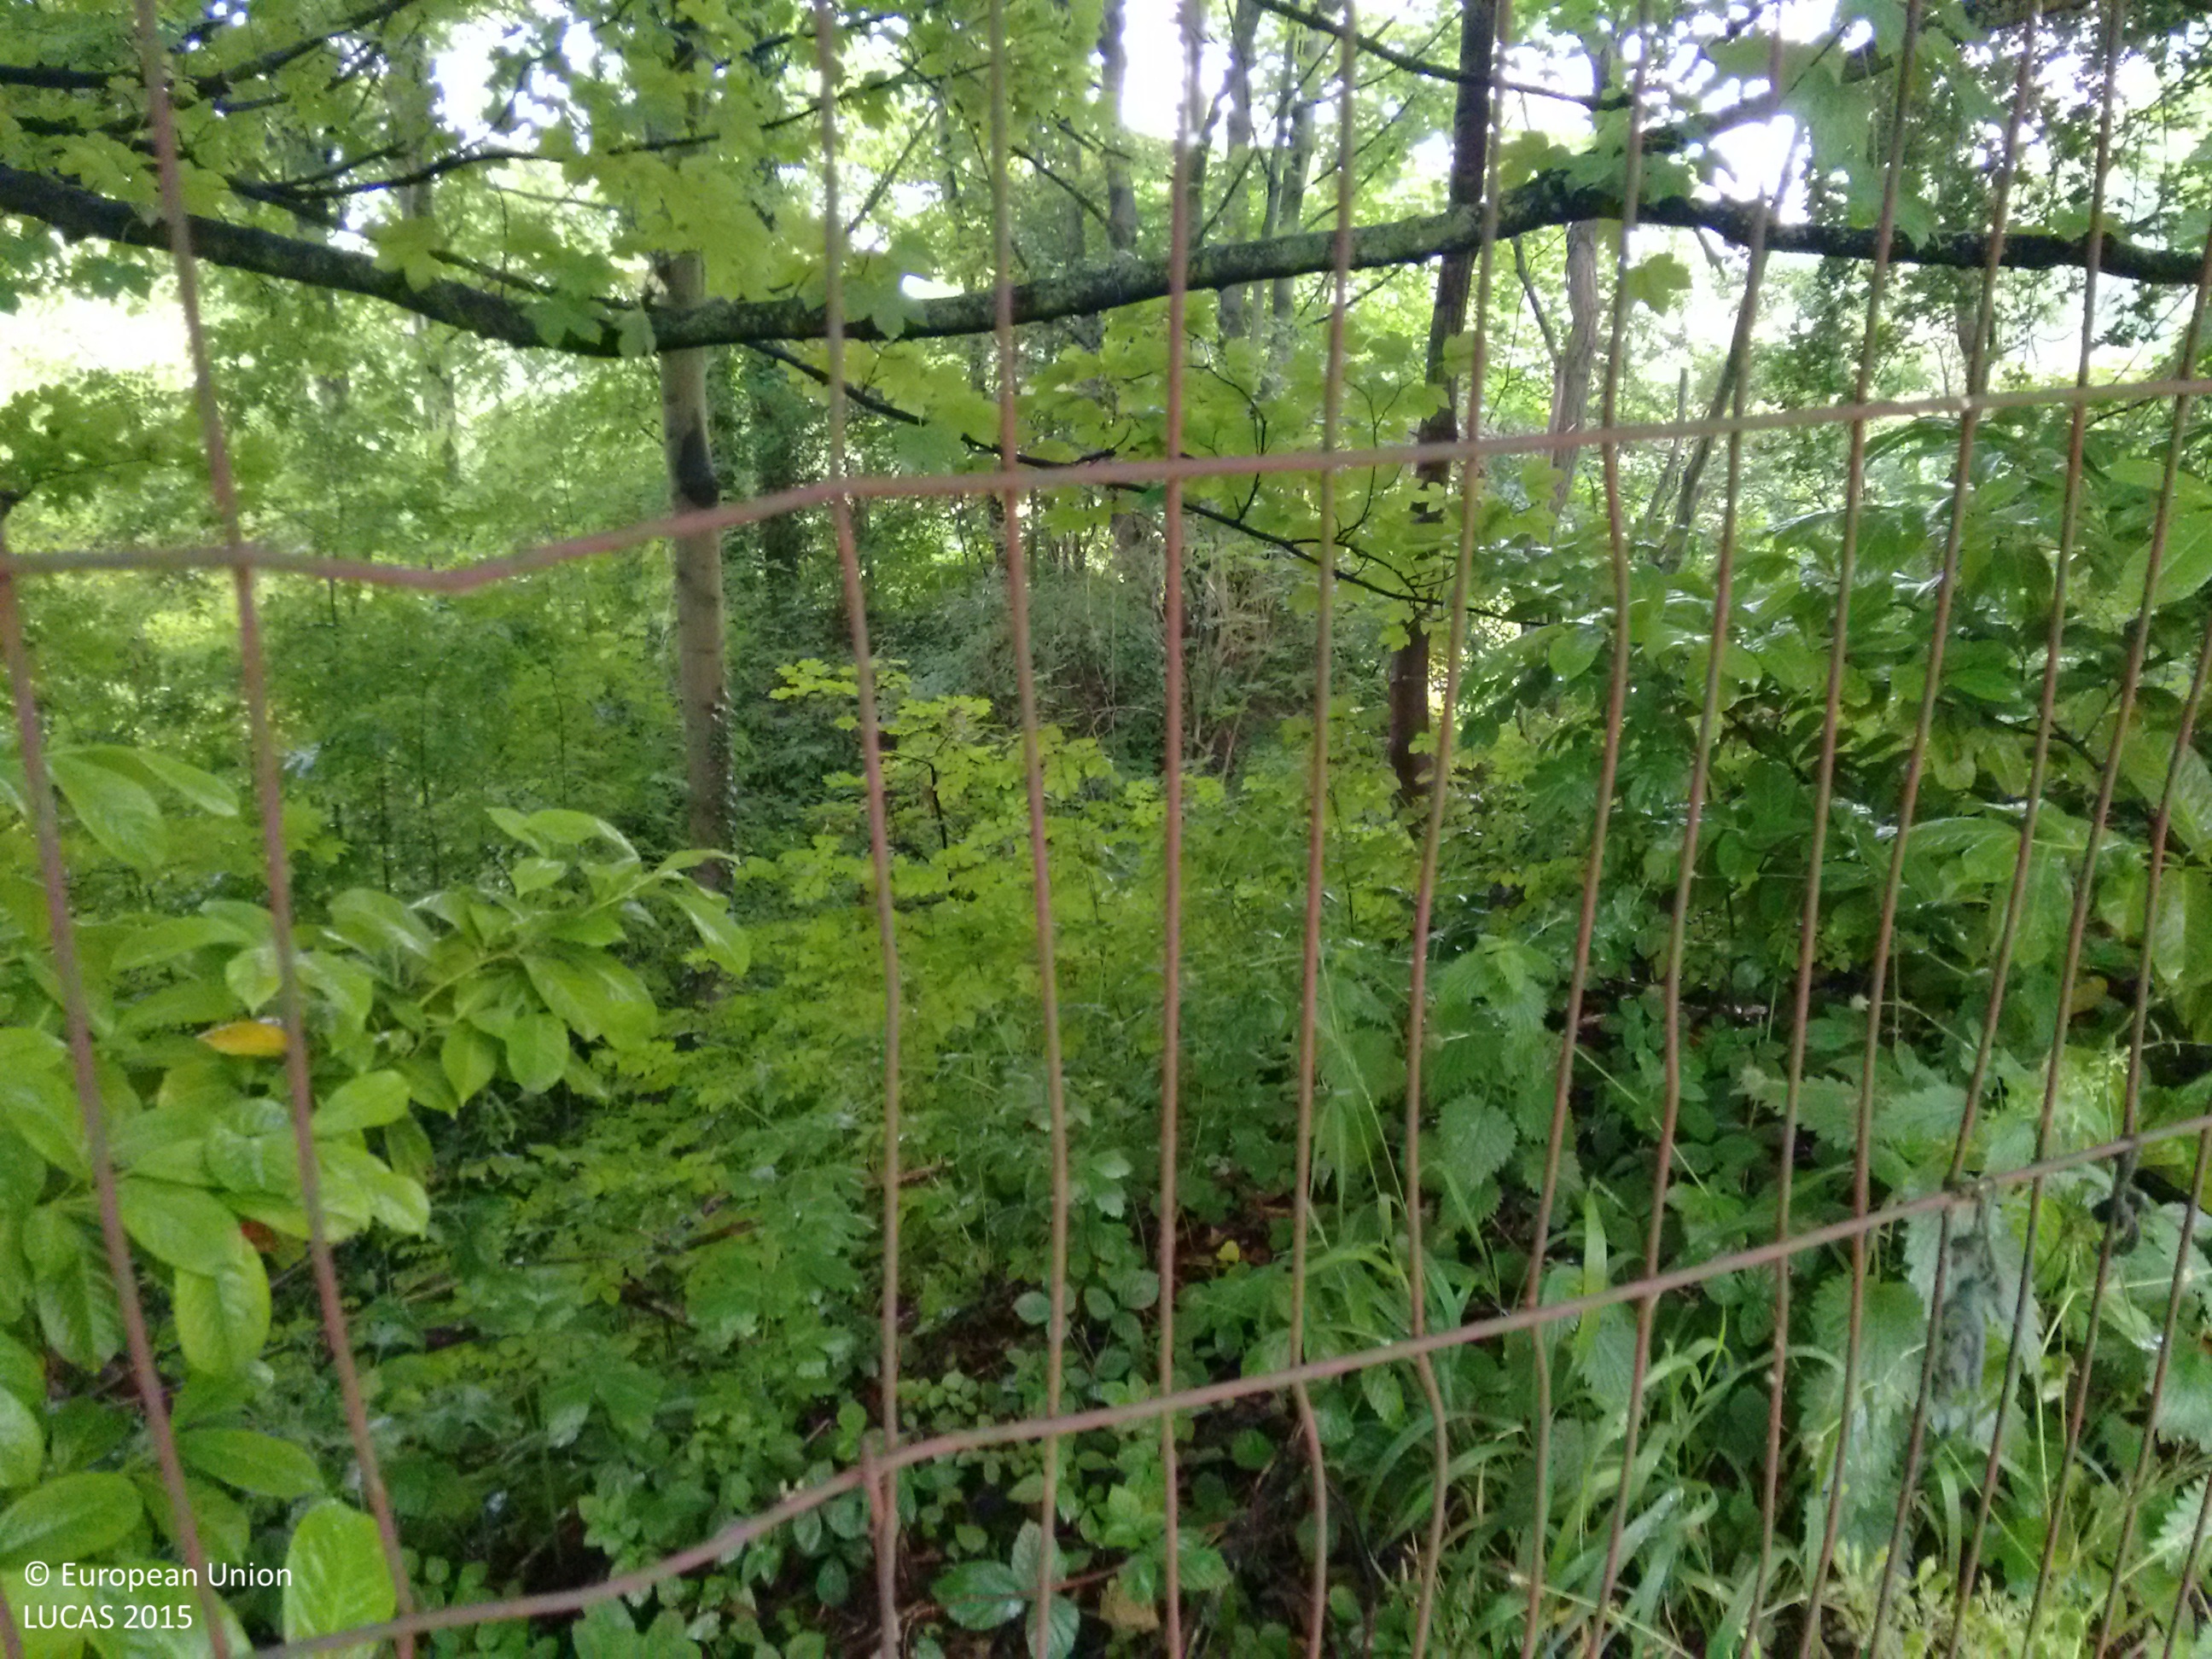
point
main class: Woodland
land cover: Broadleaved woodland
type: mesophytic deciduous forest
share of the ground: > 75 %
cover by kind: broadleaved forest trees 100 %
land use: Semi-natural and natural areas not in use
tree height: > 5 m
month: July
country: GB
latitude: 53.8196
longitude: -1.6416
